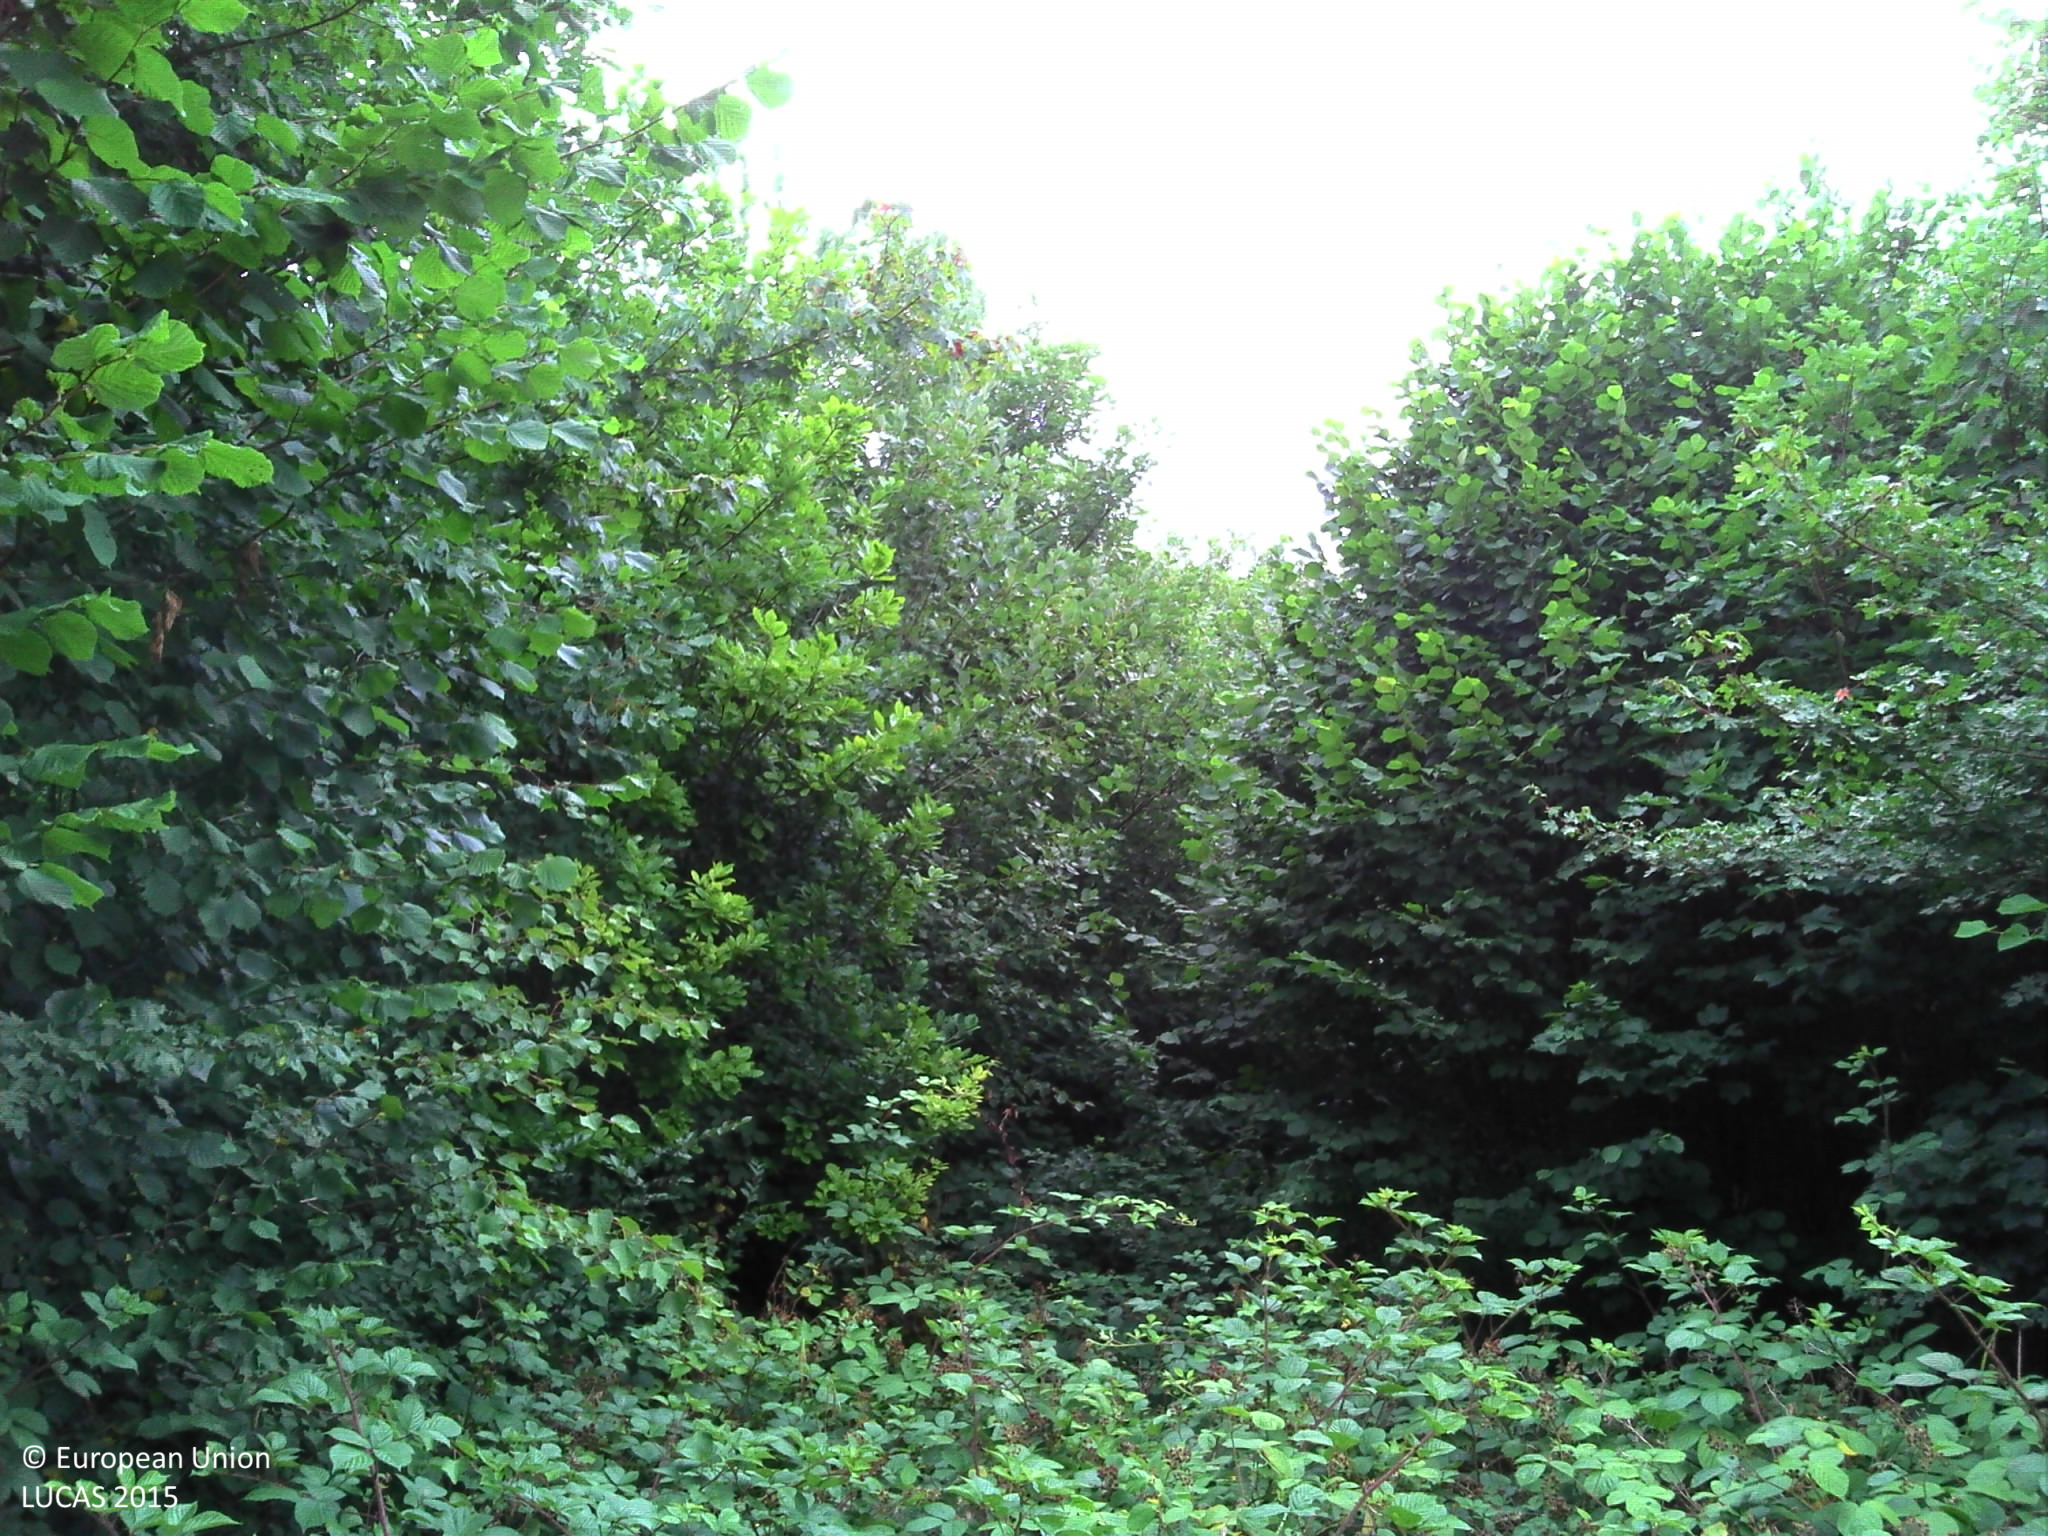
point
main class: Woodland
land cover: Broadleaved woodland
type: acidophilous oak and oak-birch forest
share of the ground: > 75 %
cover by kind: broadleaved forest trees 80 %, shrubs 15 %, herbaceous plants 5 %
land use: Forestry
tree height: > 5 m
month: July
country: FR
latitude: 49.2365
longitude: 2.5584
